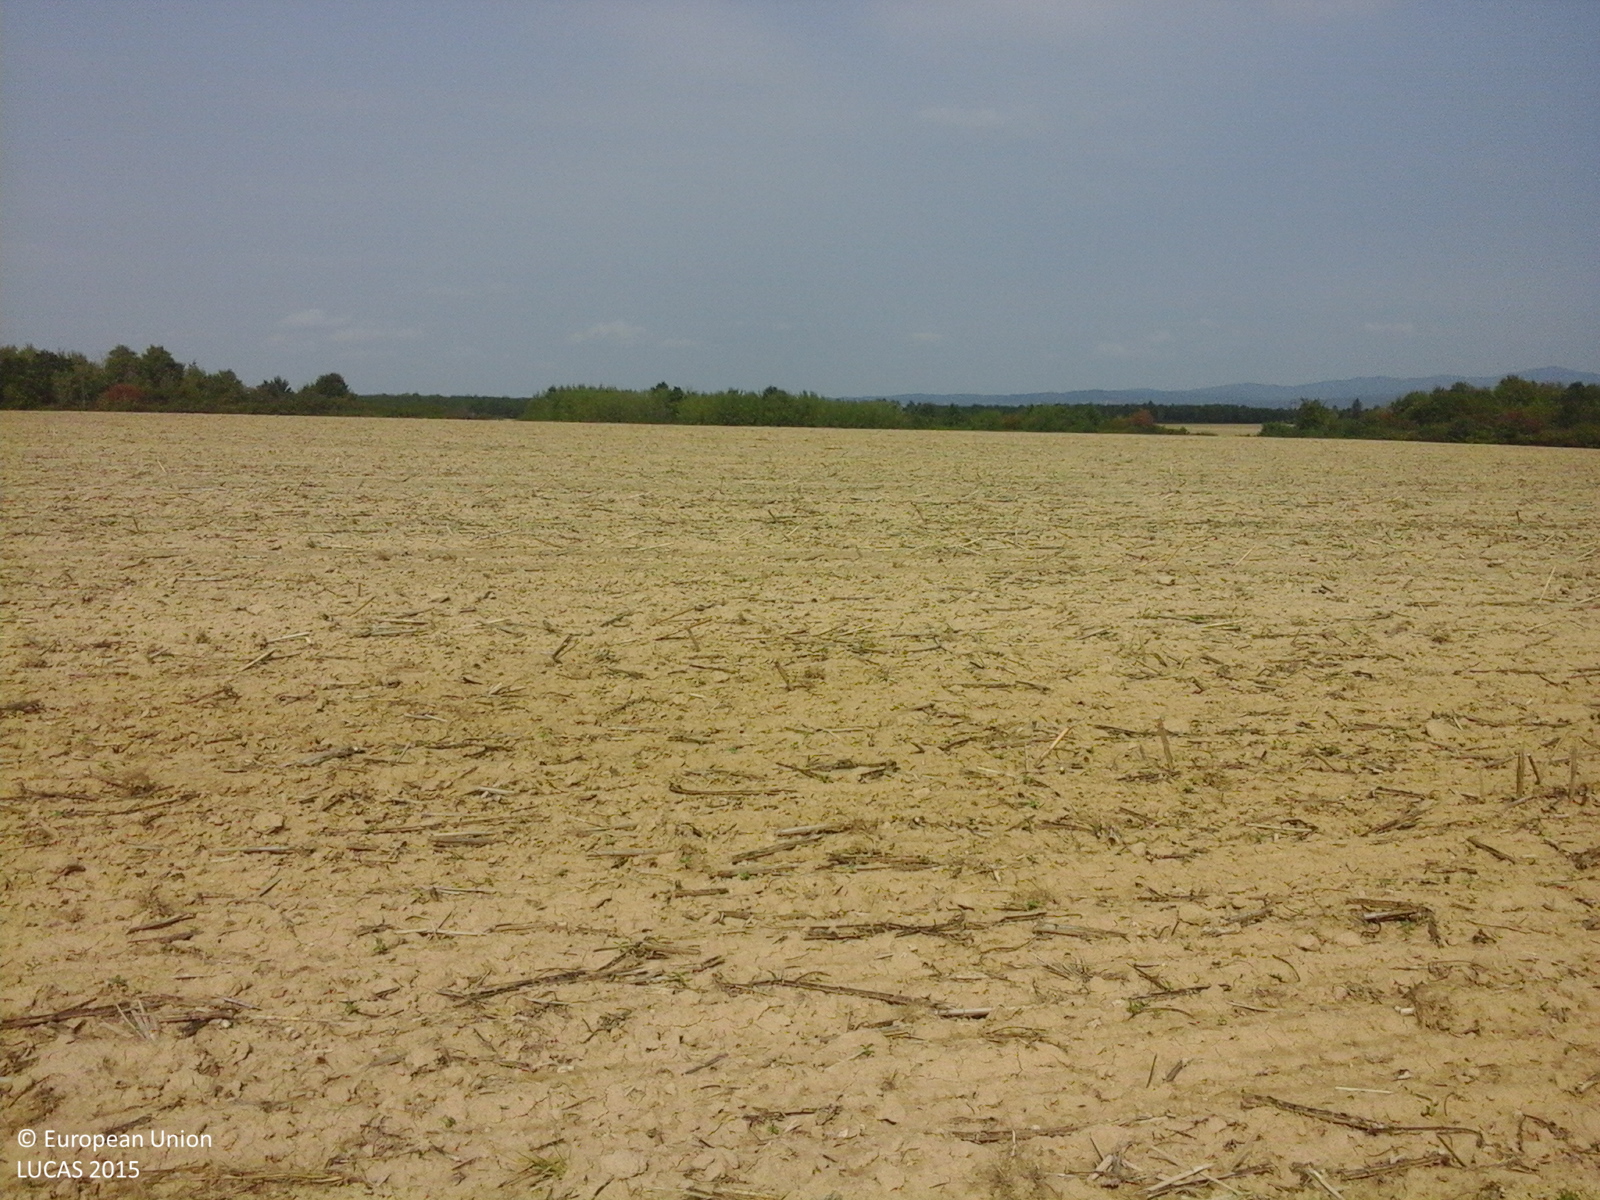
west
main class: Cropland
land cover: Sunflower
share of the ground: < 10 %
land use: Agriculture (excluding fallow land and kitchen gardens)
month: September
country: RO
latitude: 45.5352
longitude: 22.0900
